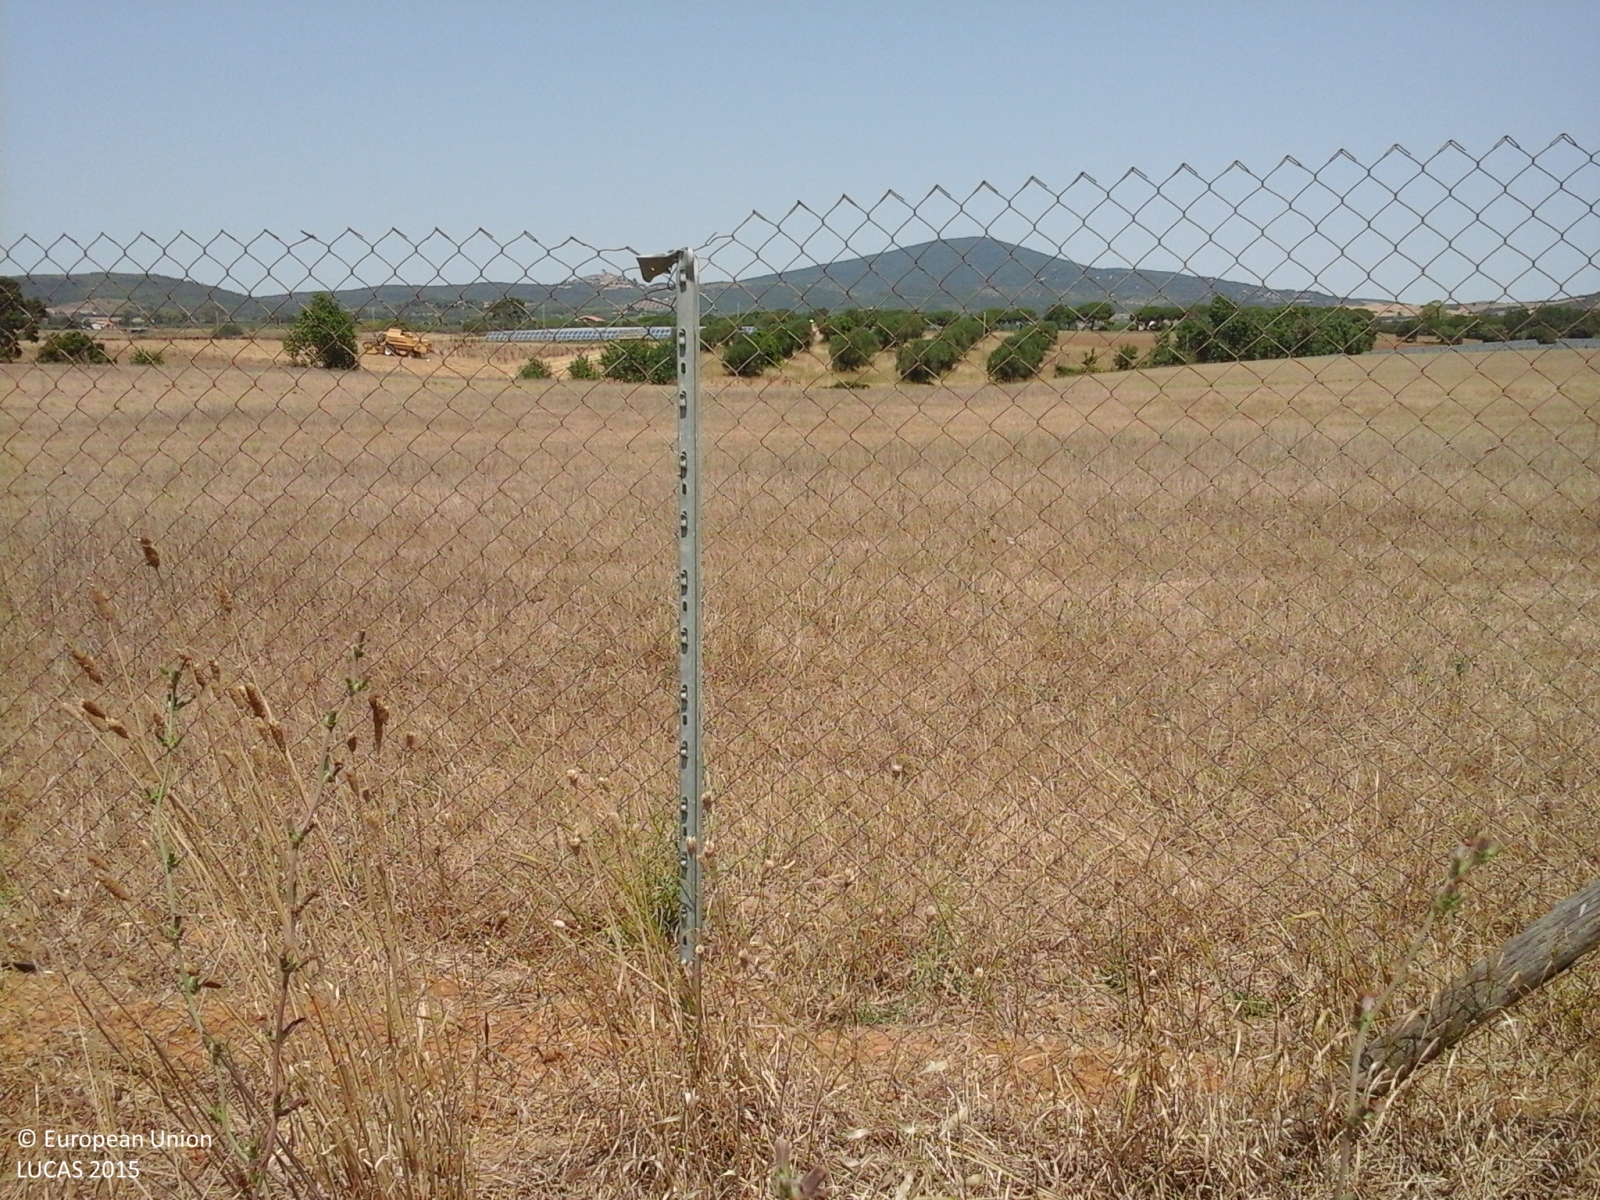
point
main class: Grassland
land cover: Grassland without tree/shrub cover
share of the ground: > 75 %
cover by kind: herbaceous plants 100 %
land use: Agriculture (excluding fallow land and kitchen gardens)
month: July
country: IT
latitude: 42.4089
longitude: 11.4409
